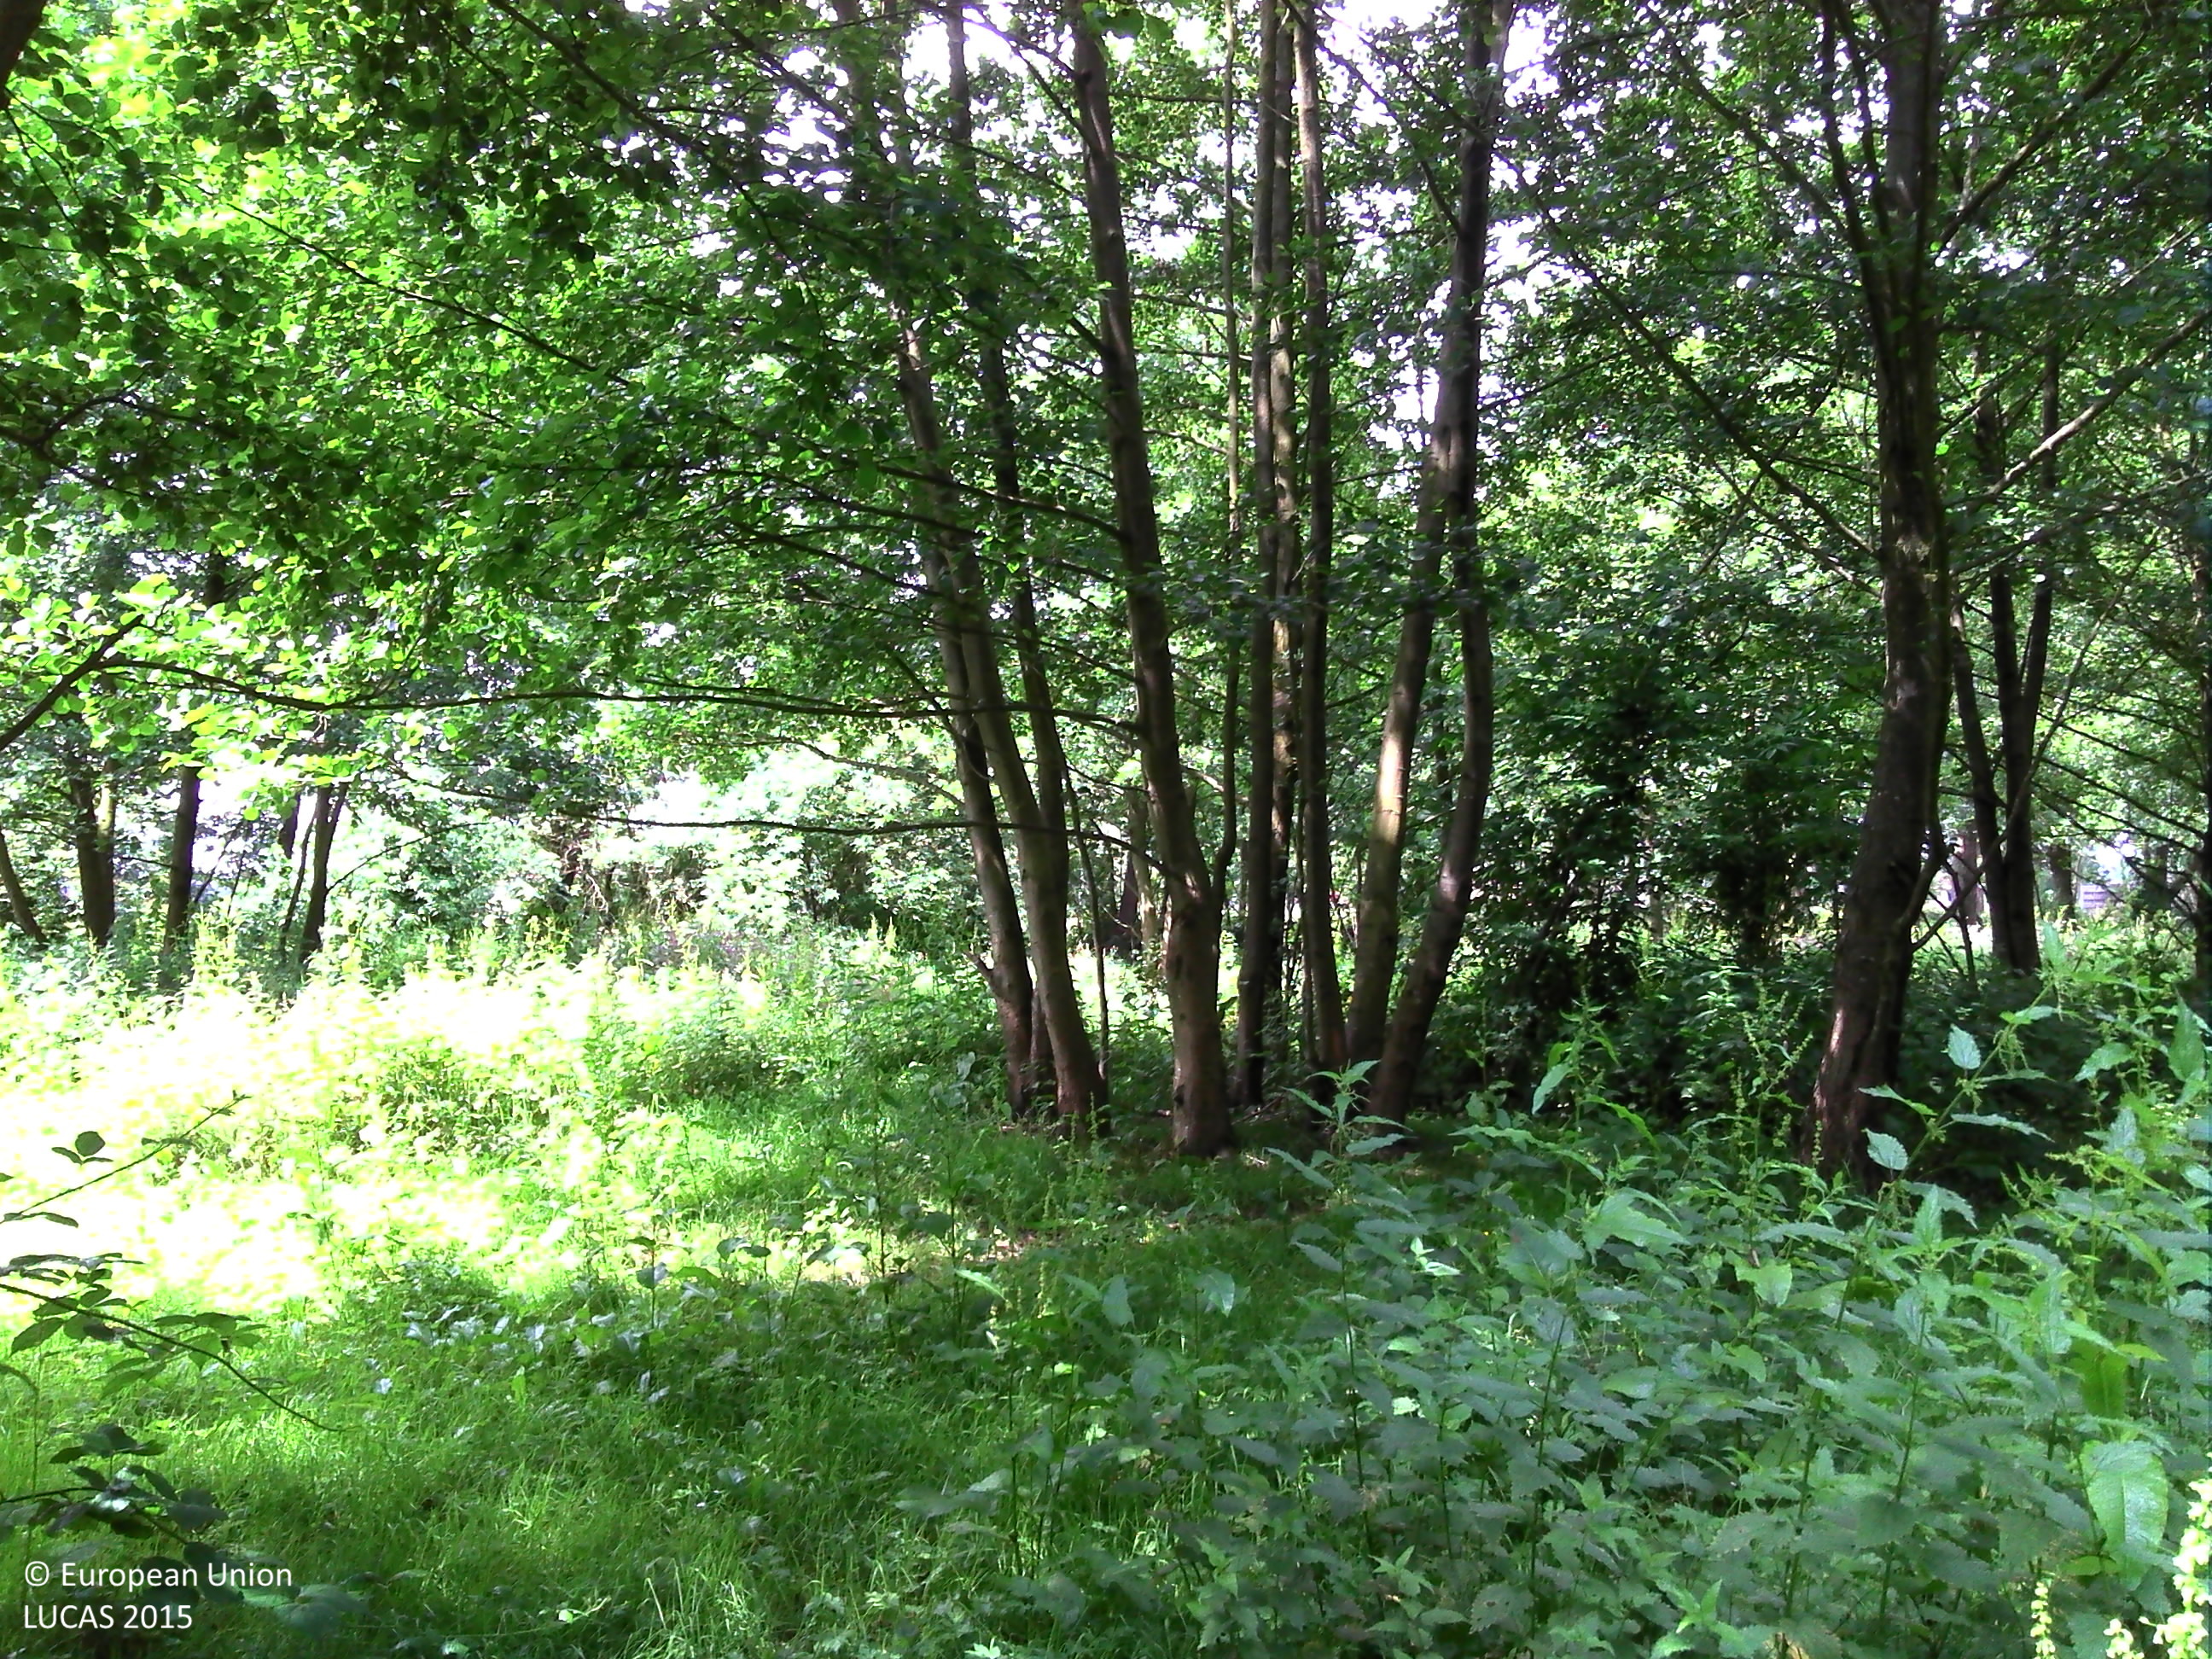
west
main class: Woodland
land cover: Broadleaved woodland
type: non-riverine alder, birch or aspen forest
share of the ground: > 75 %
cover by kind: broadleaved forest trees 60 %, herbaceous plants 40 %
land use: Semi-natural and natural areas not in use
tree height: > 5 m
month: June
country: BE
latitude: 51.1800
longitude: 5.6066
